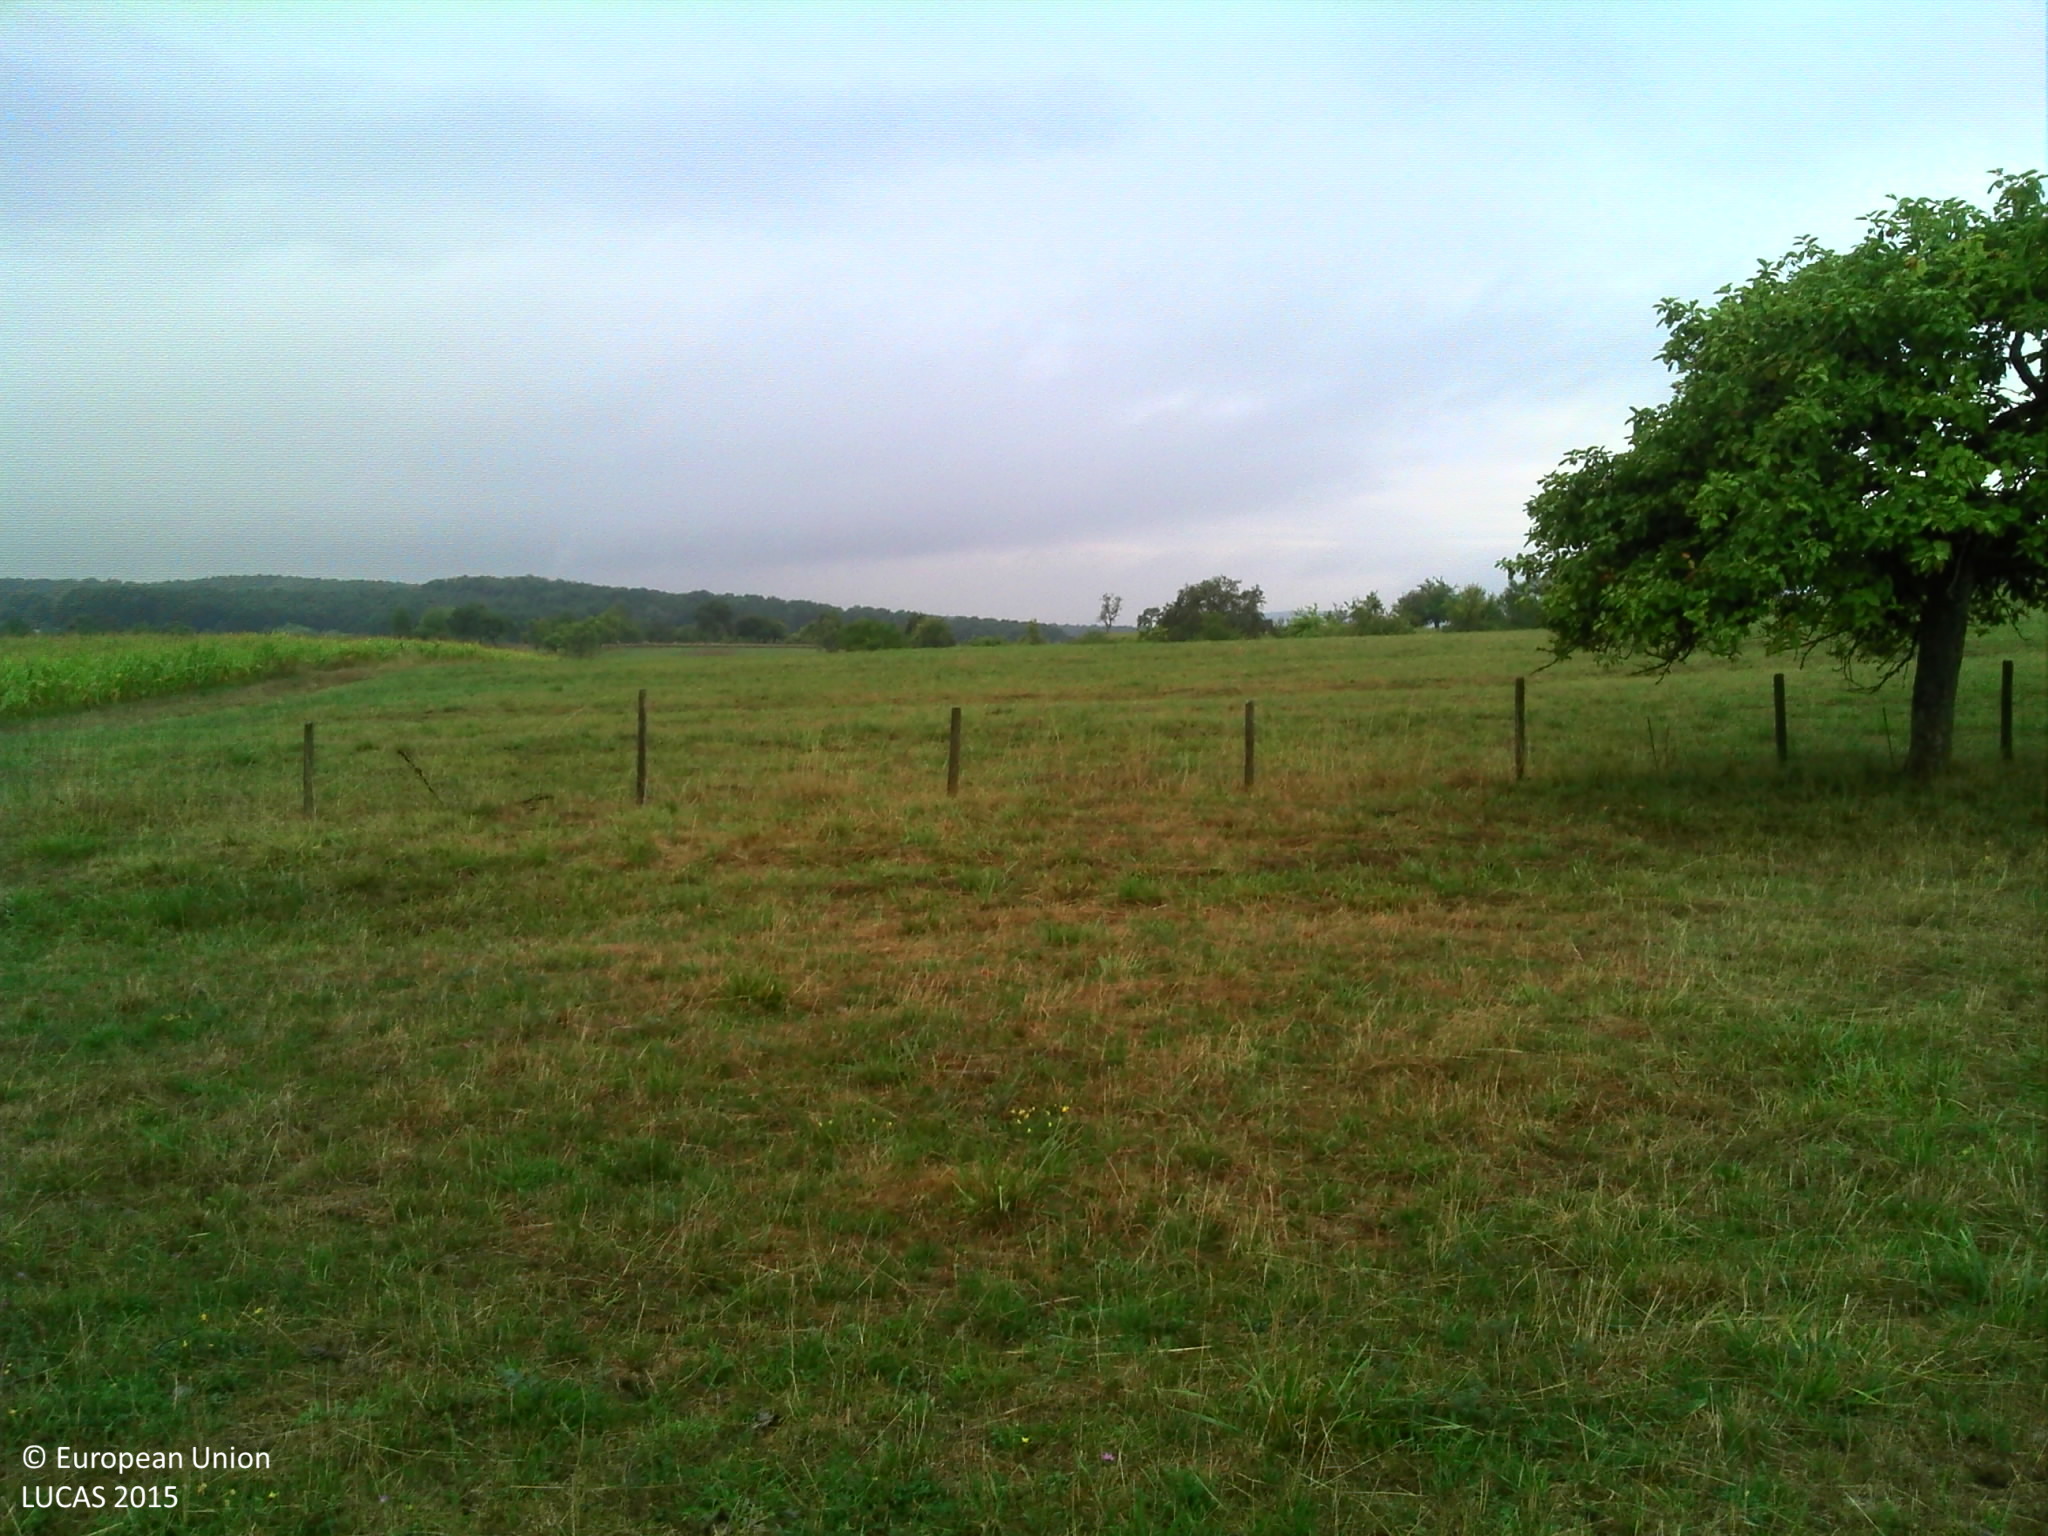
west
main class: Grassland
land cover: Grassland with sparse tree/shrub cover
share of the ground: > 75 %
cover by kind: herbaceous plants 95 %, broadleaved forest trees 5 %
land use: Agriculture (excluding fallow land and kitchen gardens)
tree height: > 5 m
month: August
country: FR
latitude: 48.8800
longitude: 7.5325
